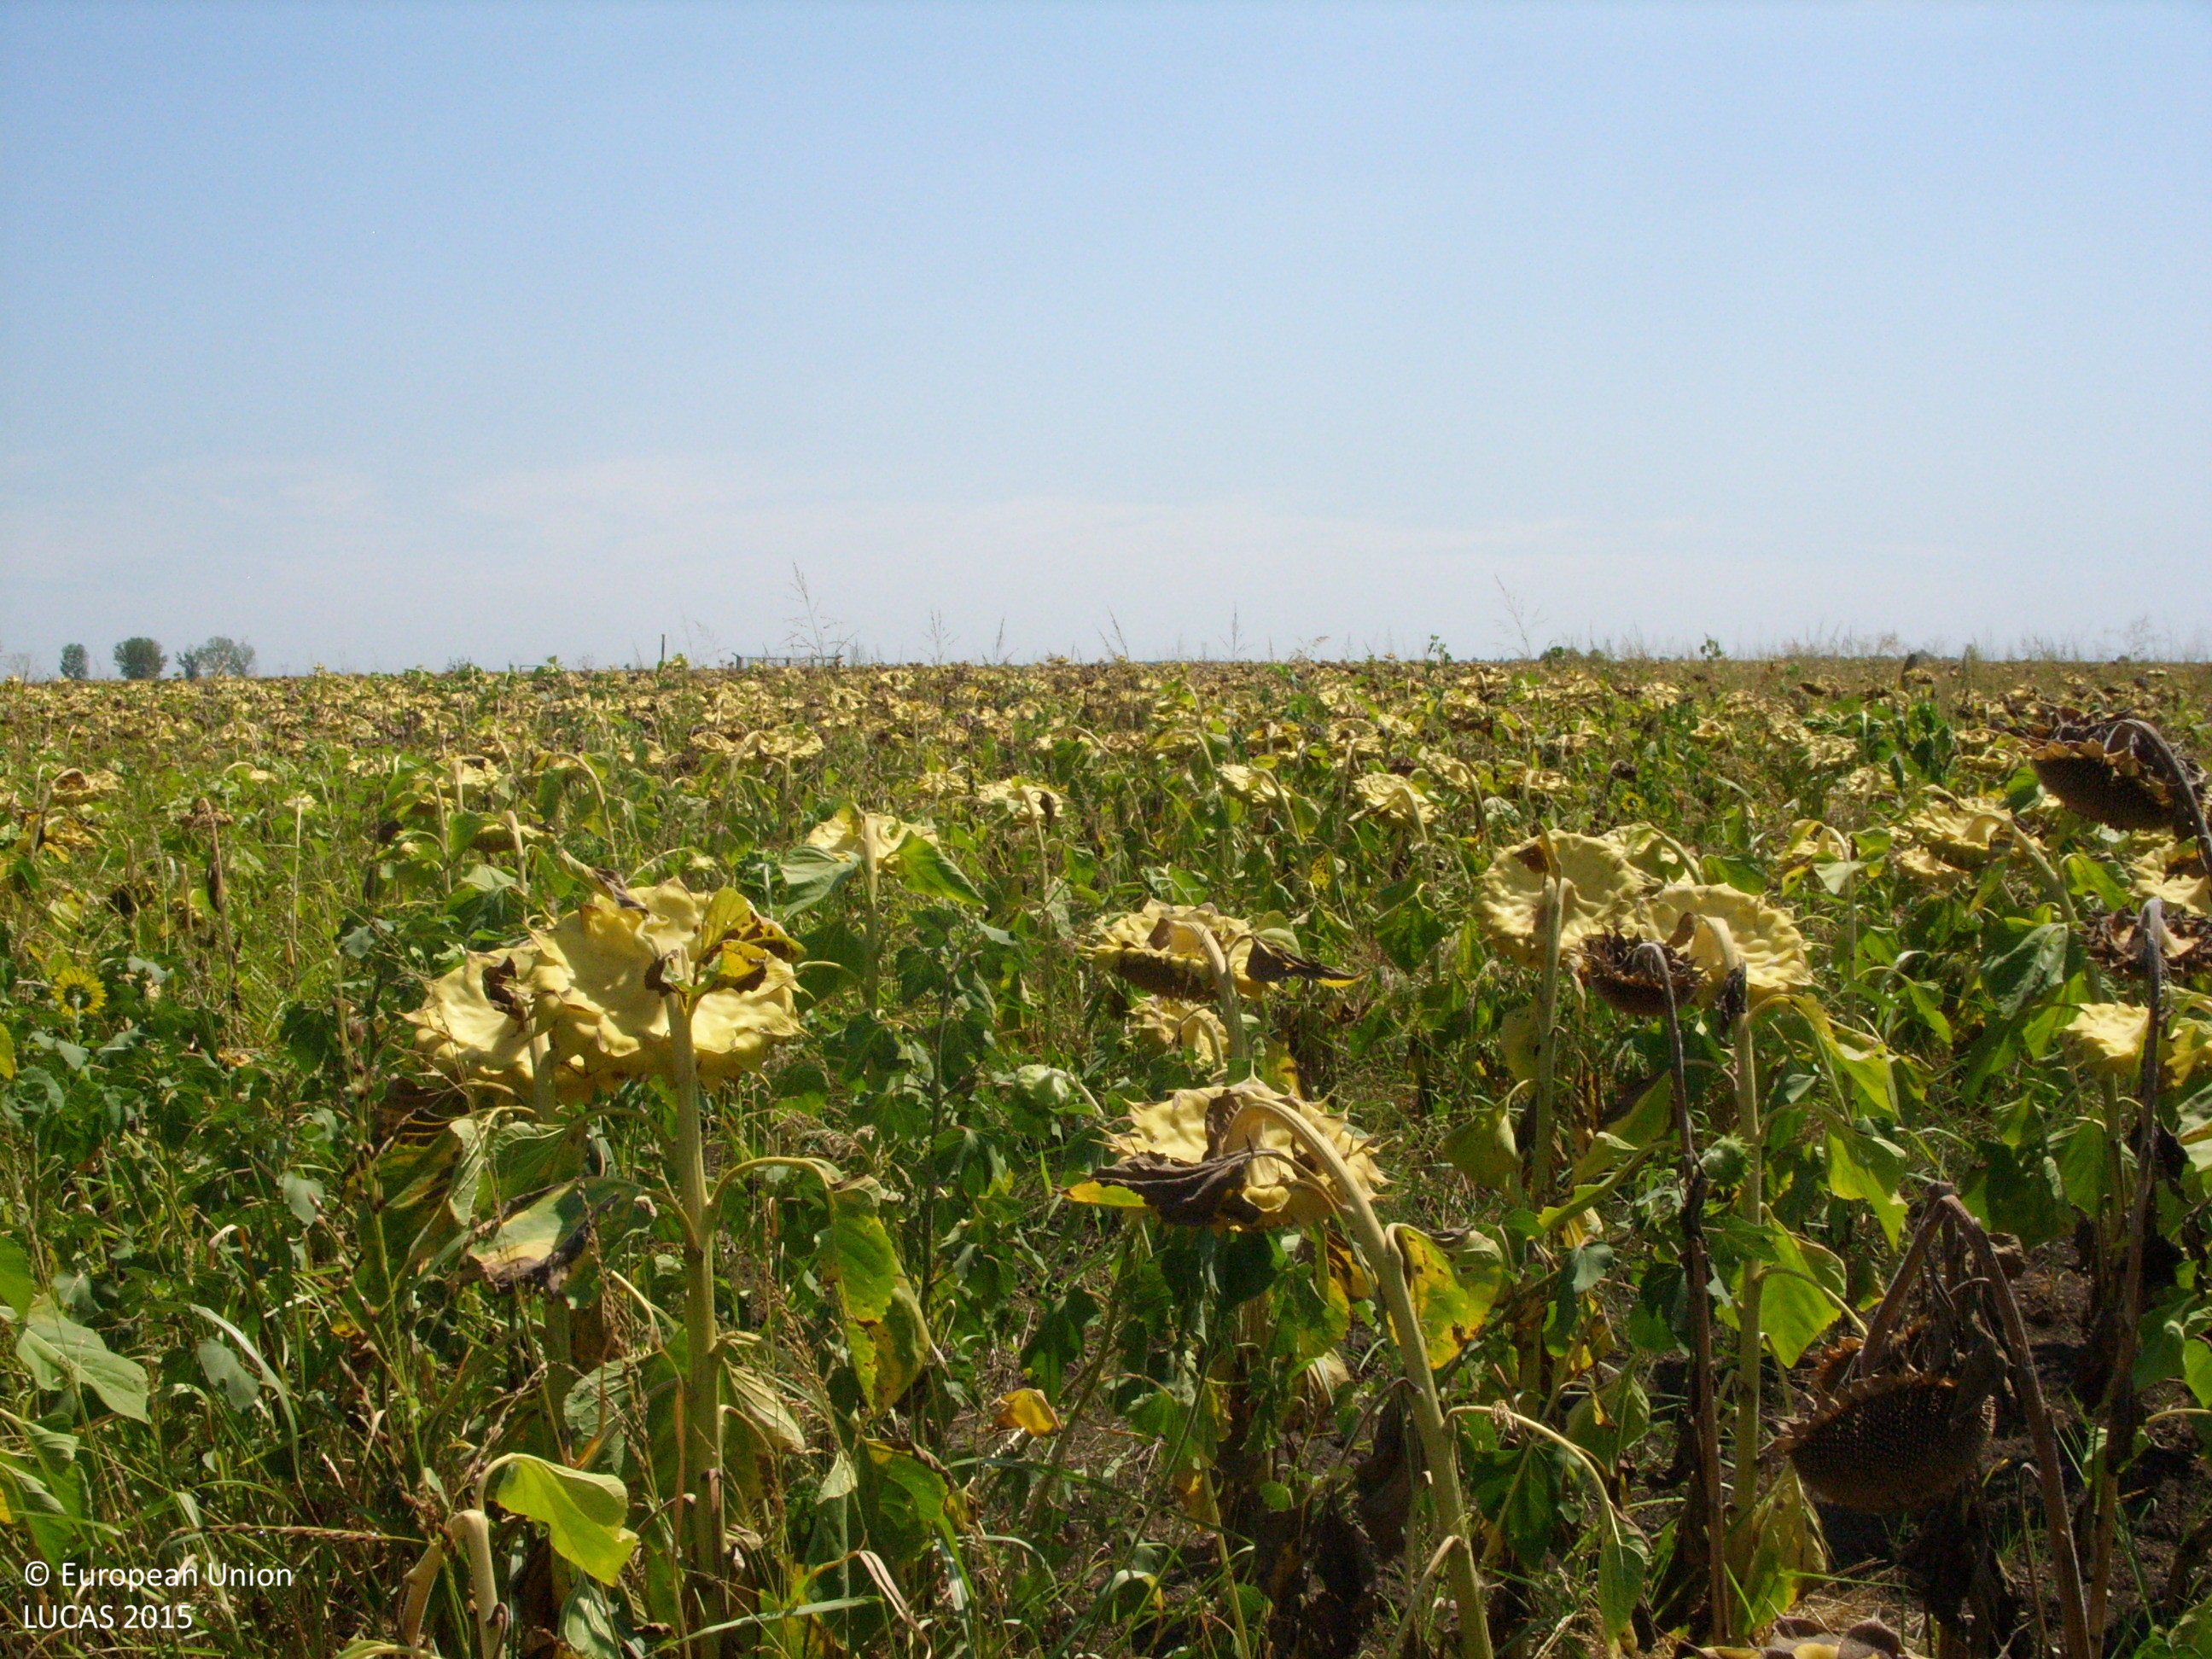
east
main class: Cropland
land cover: Sunflower
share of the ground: > 75 %
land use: Agriculture (excluding fallow land and kitchen gardens)
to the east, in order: Grass margins; Sunflower
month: August
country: BG
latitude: 42.3048
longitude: 24.5954
